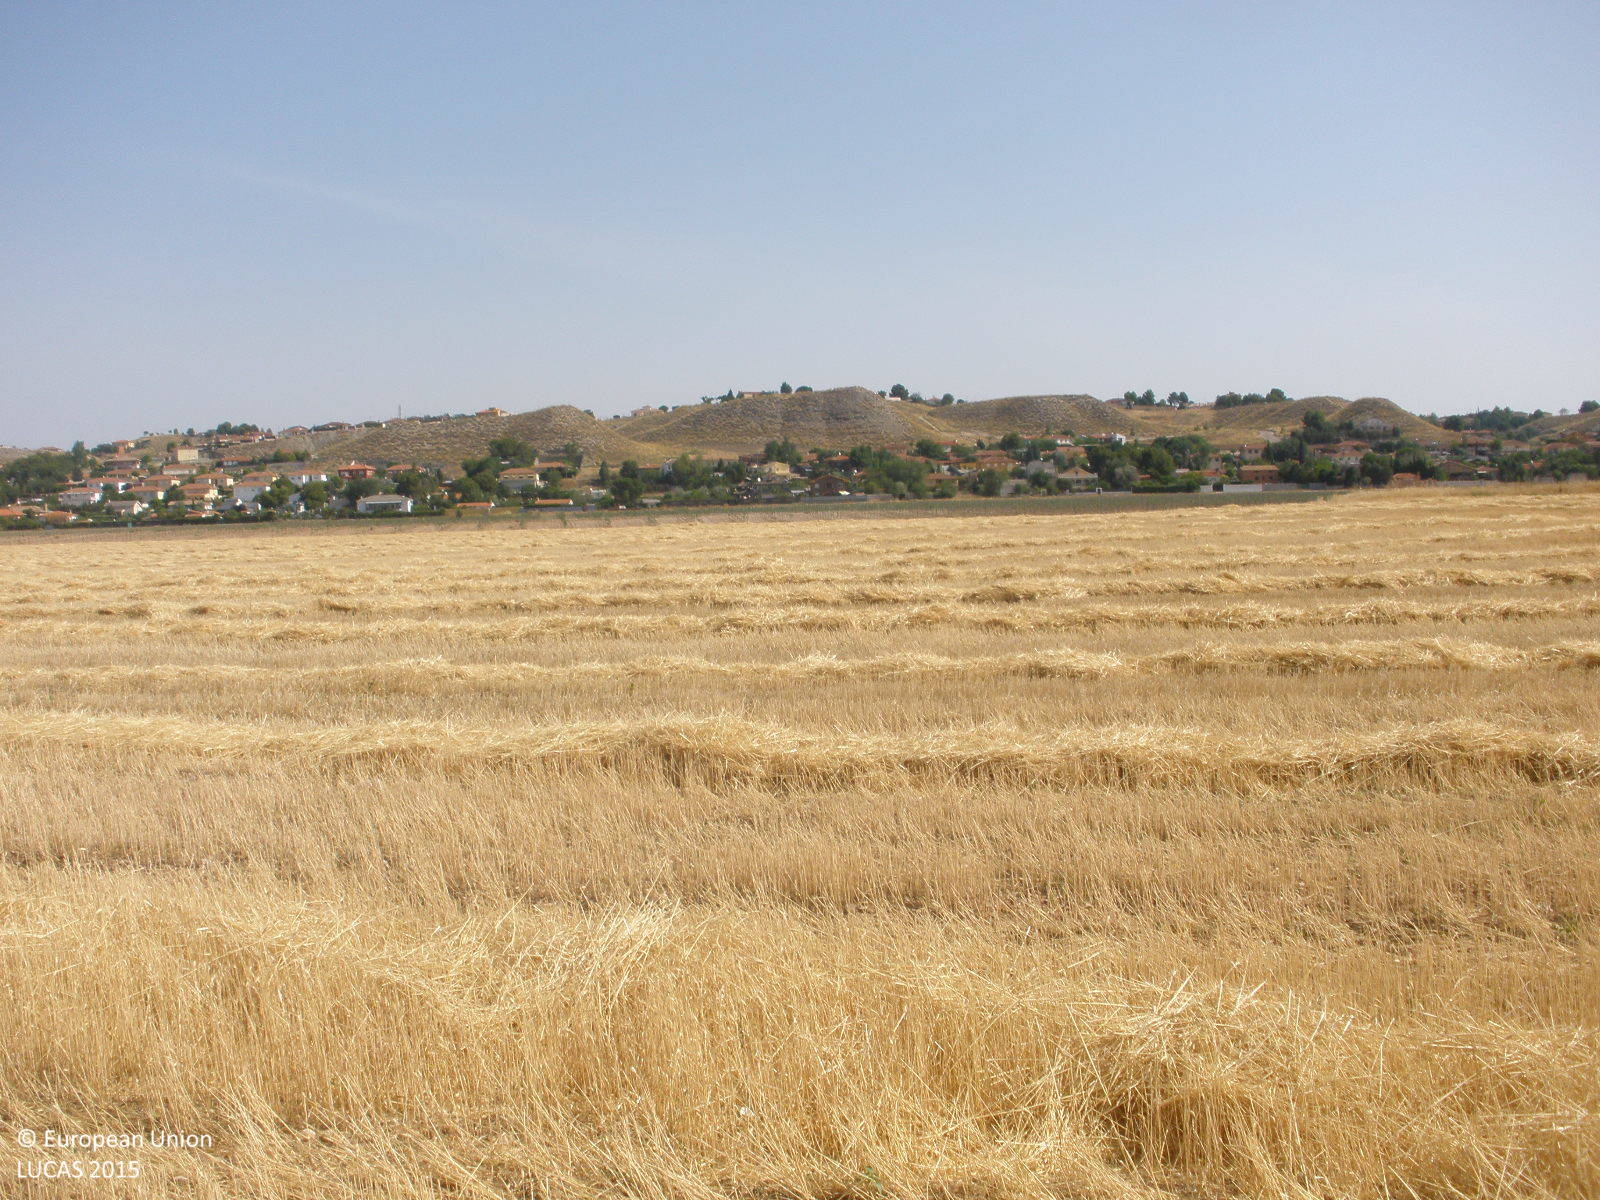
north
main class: Cropland
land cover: Barley
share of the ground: < 10 %
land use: Agriculture (excluding fallow land and kitchen gardens)
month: July
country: ES
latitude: 40.0620
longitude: -3.5010
